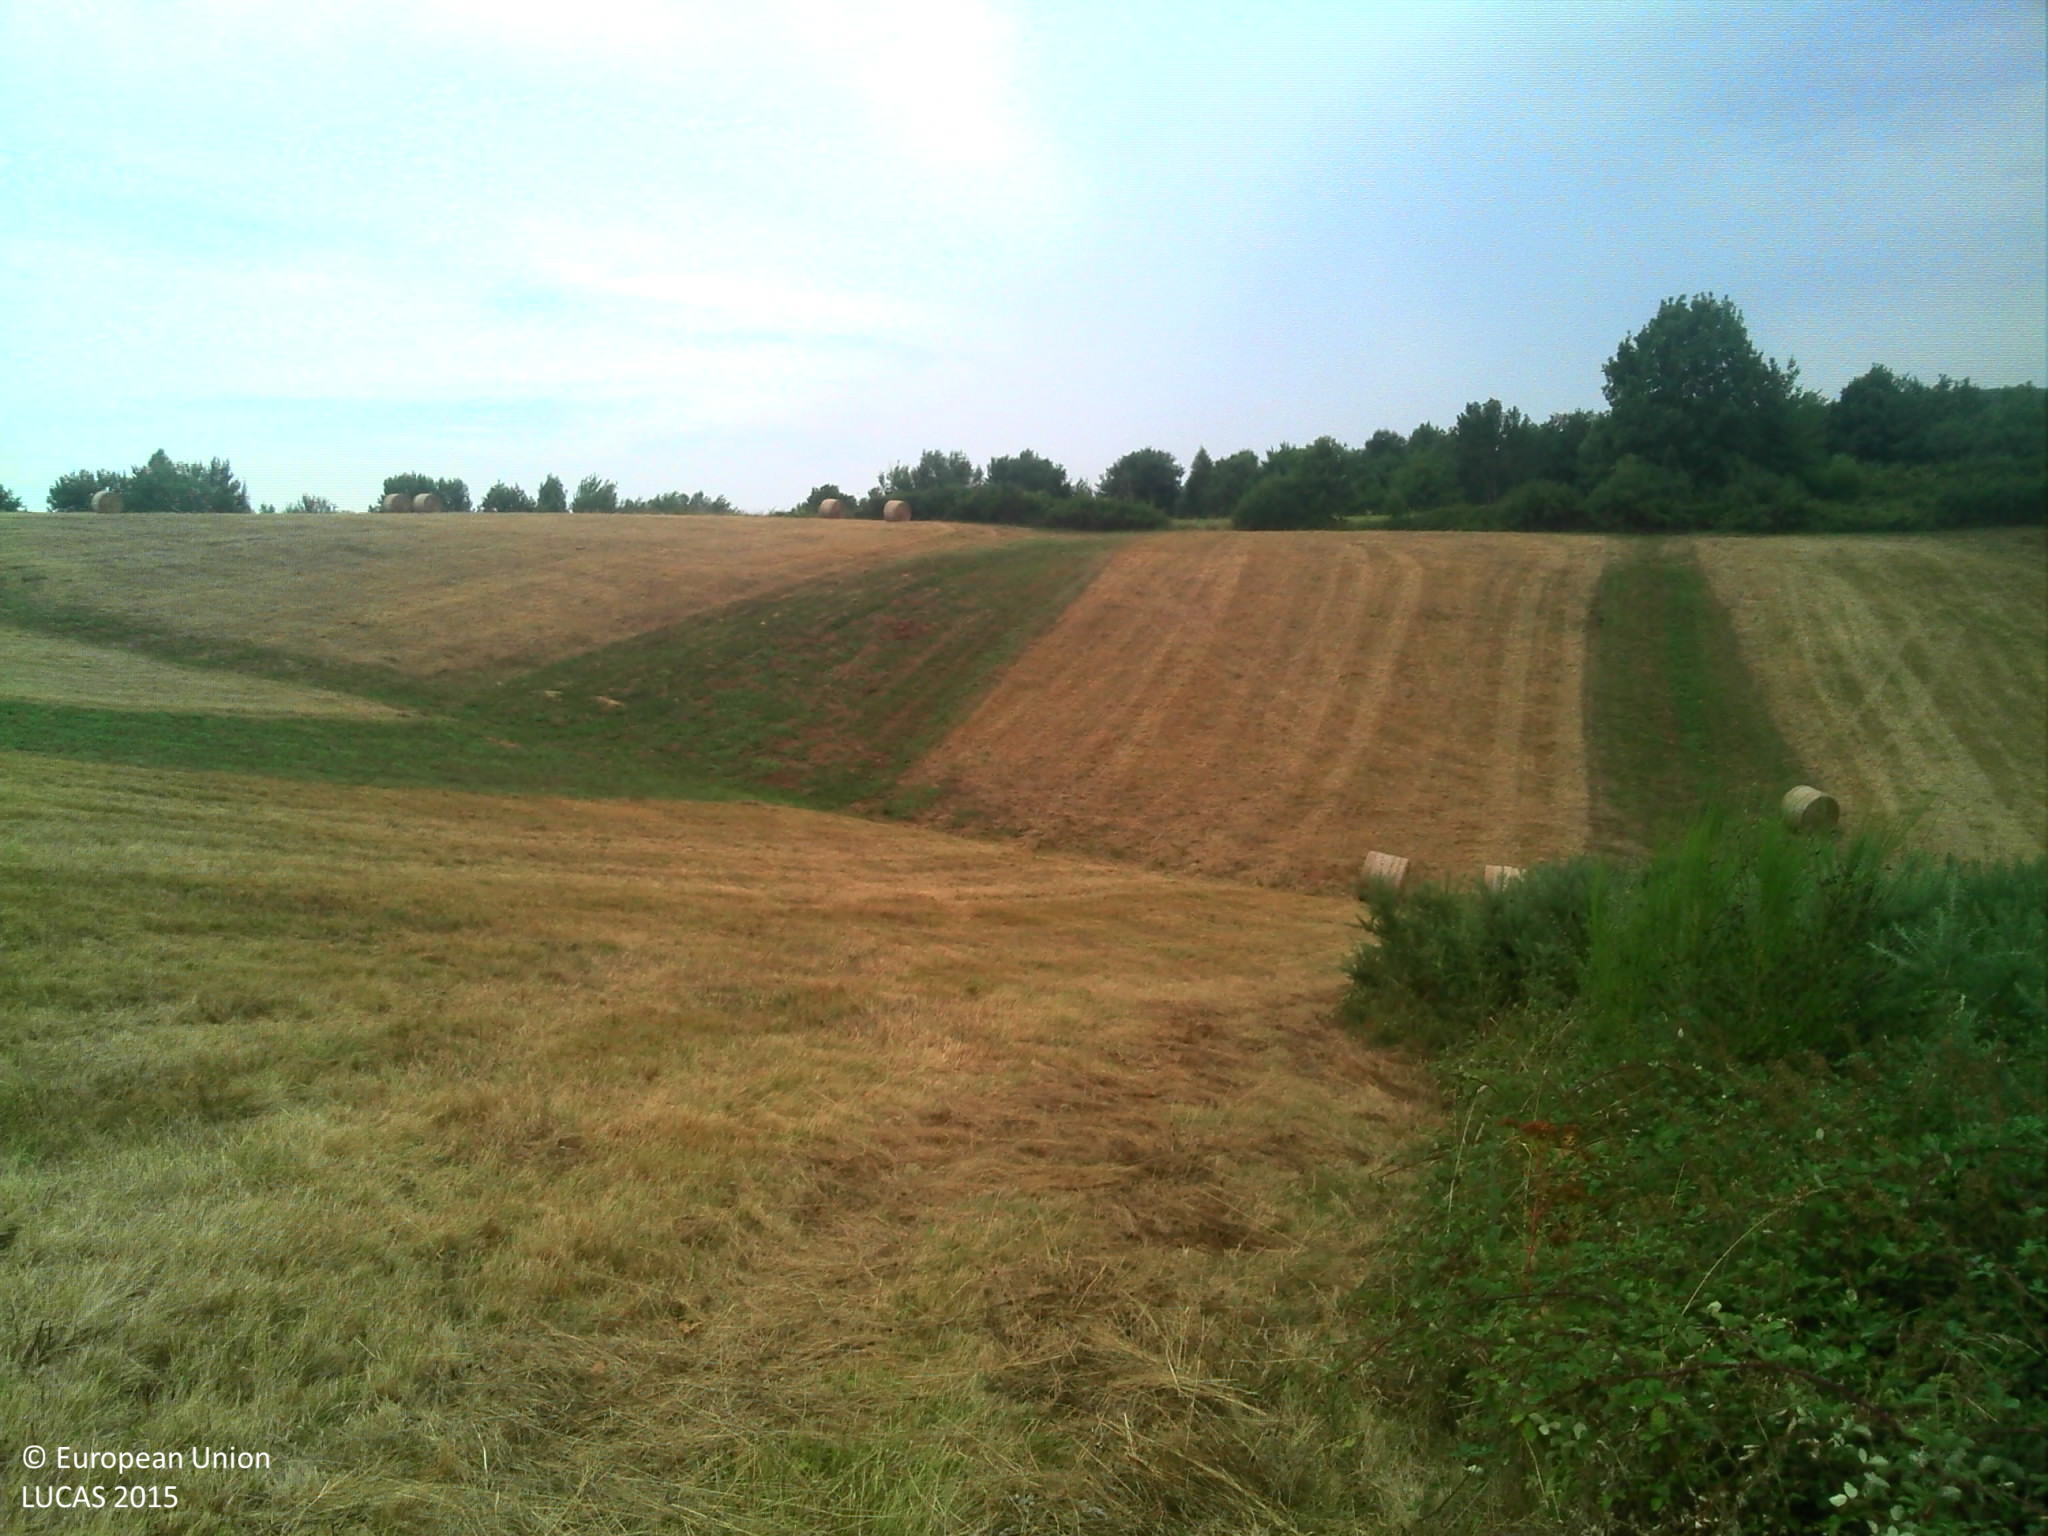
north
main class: Shrubland
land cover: Shrubland without tree cover
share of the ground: > 75 %
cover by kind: shrubs 100 %
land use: Semi-natural and natural areas not in use
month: July
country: FR
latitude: 43.1755
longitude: 0.7630
